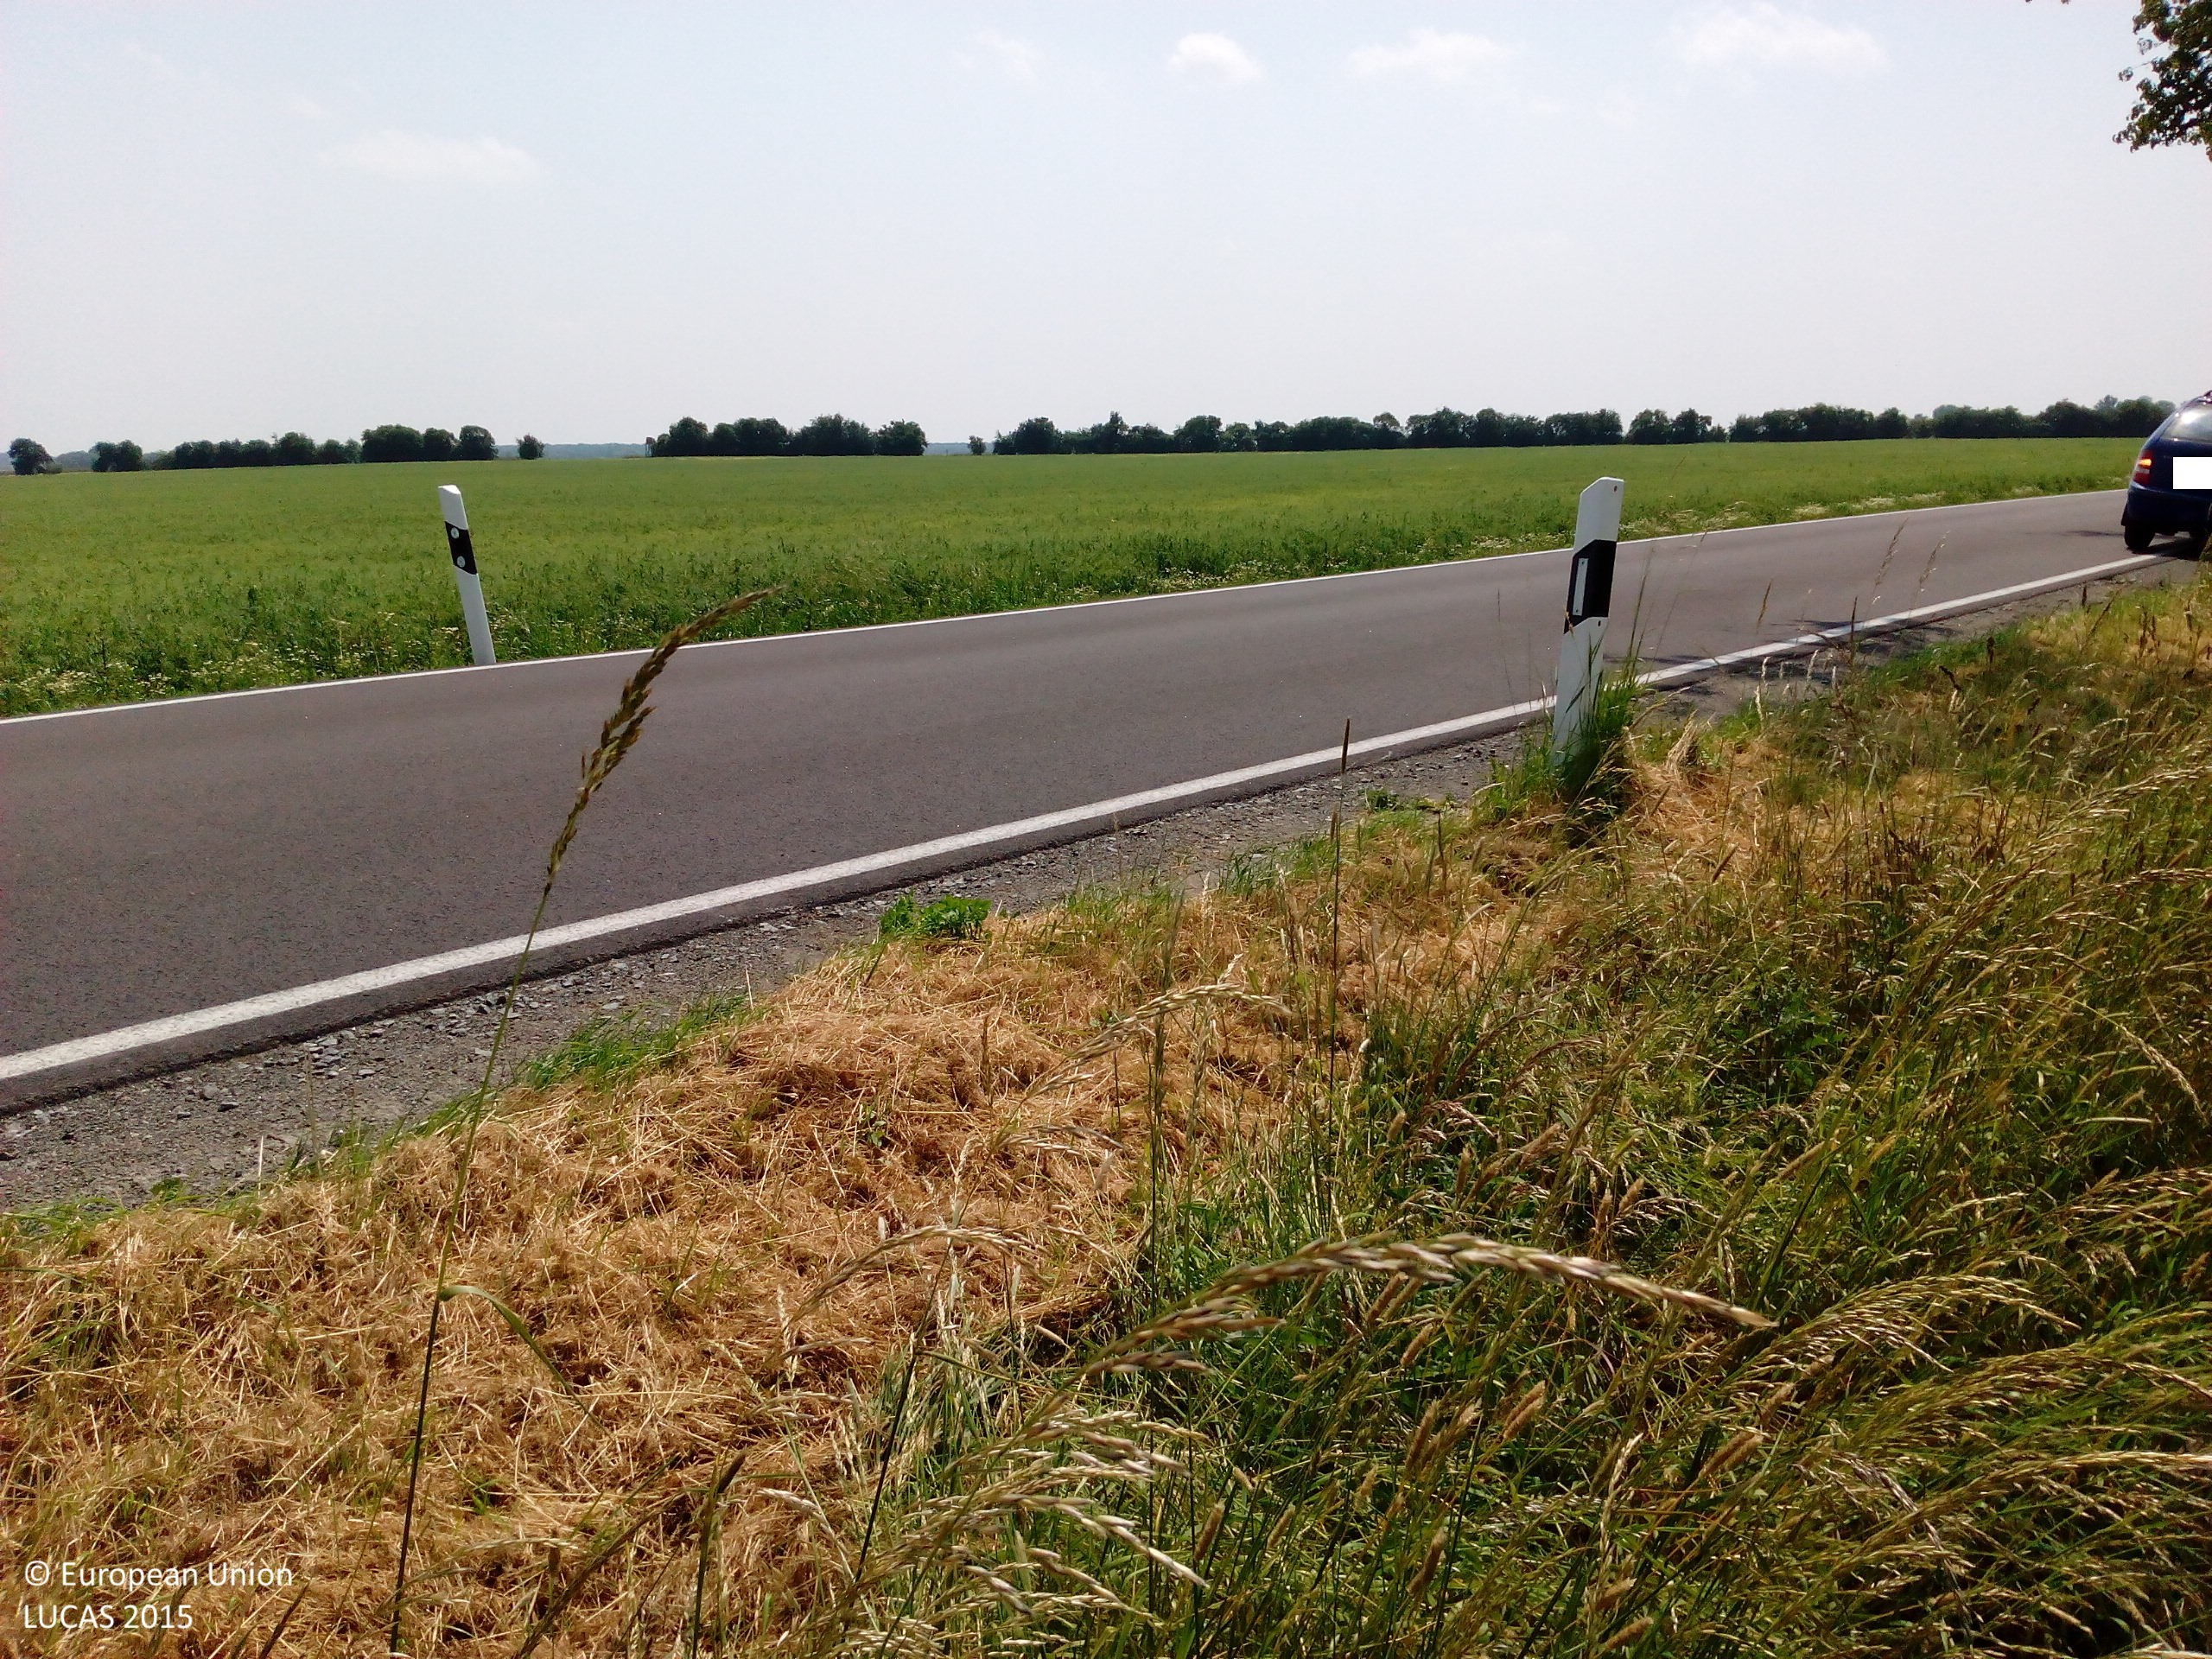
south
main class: Cropland
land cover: Common wheat
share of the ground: > 75 %
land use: Agriculture (excluding fallow land and kitchen gardens)
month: June
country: DE
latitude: 51.4342
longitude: 12.4883
